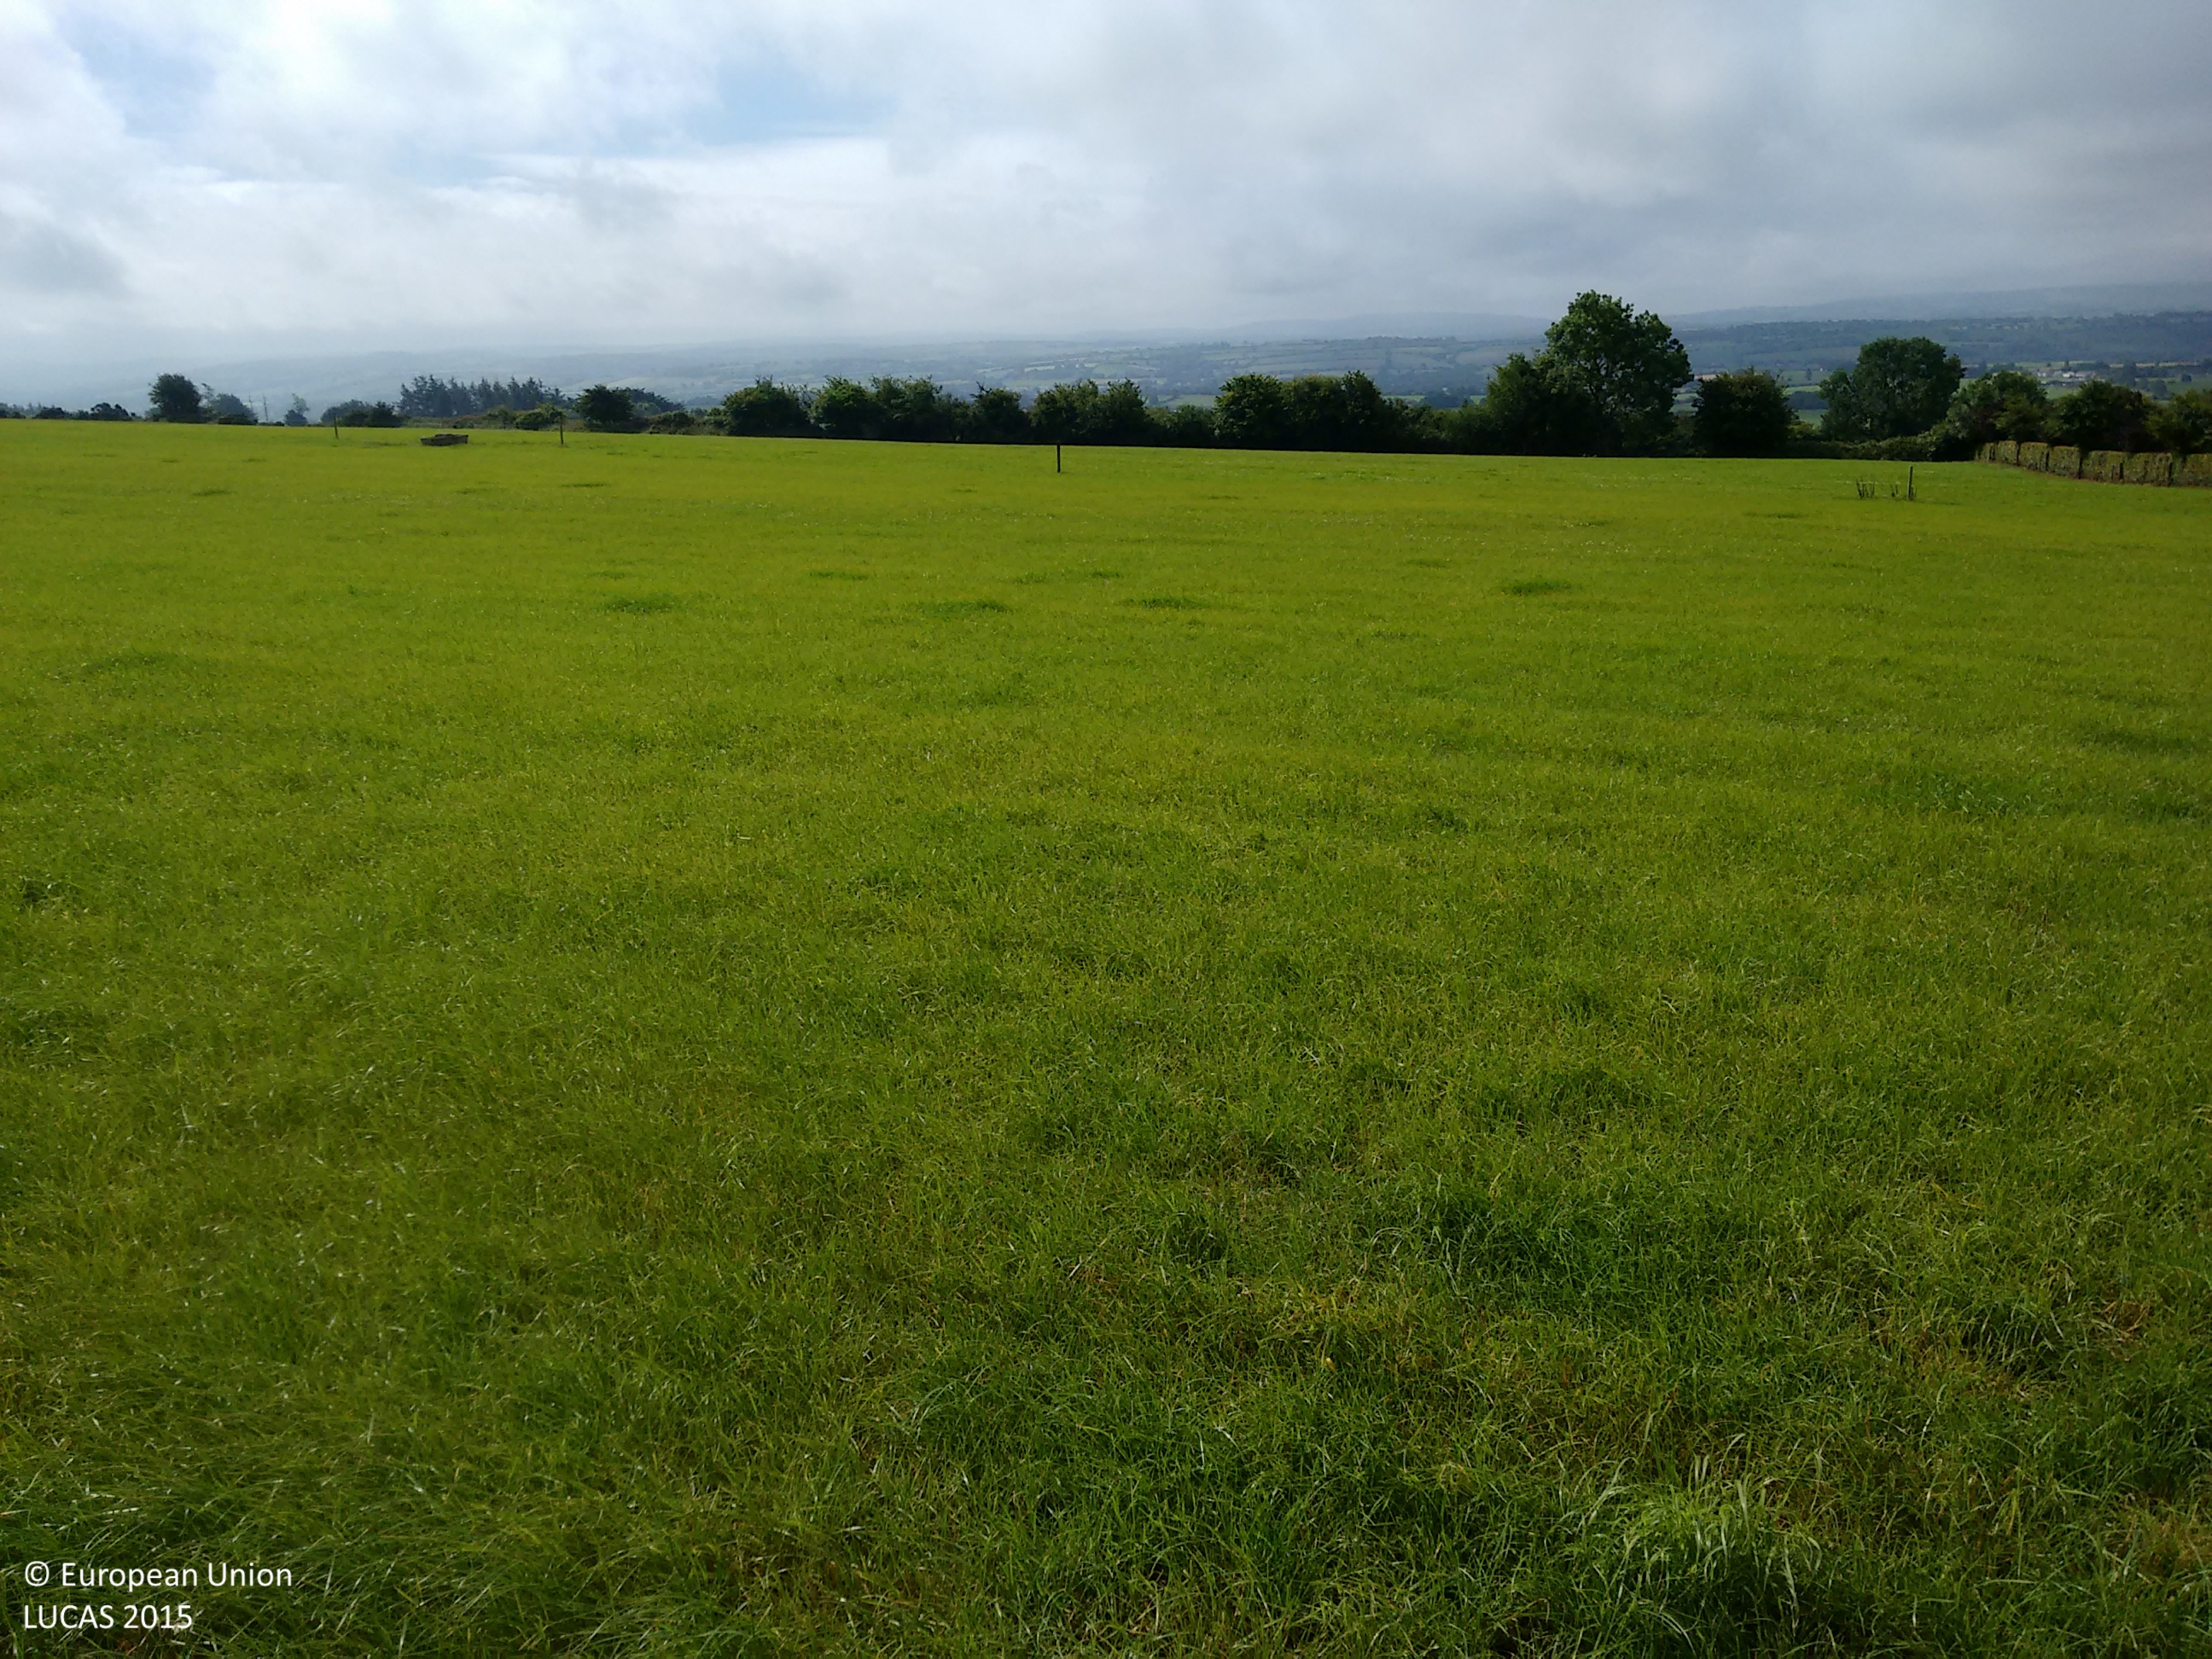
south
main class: Grassland
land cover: Grassland without tree/shrub cover
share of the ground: > 75 %
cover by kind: herbaceous plants 100 %
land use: Agriculture (excluding fallow land and kitchen gardens)
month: June
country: IE
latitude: 52.1262
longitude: -8.1328
